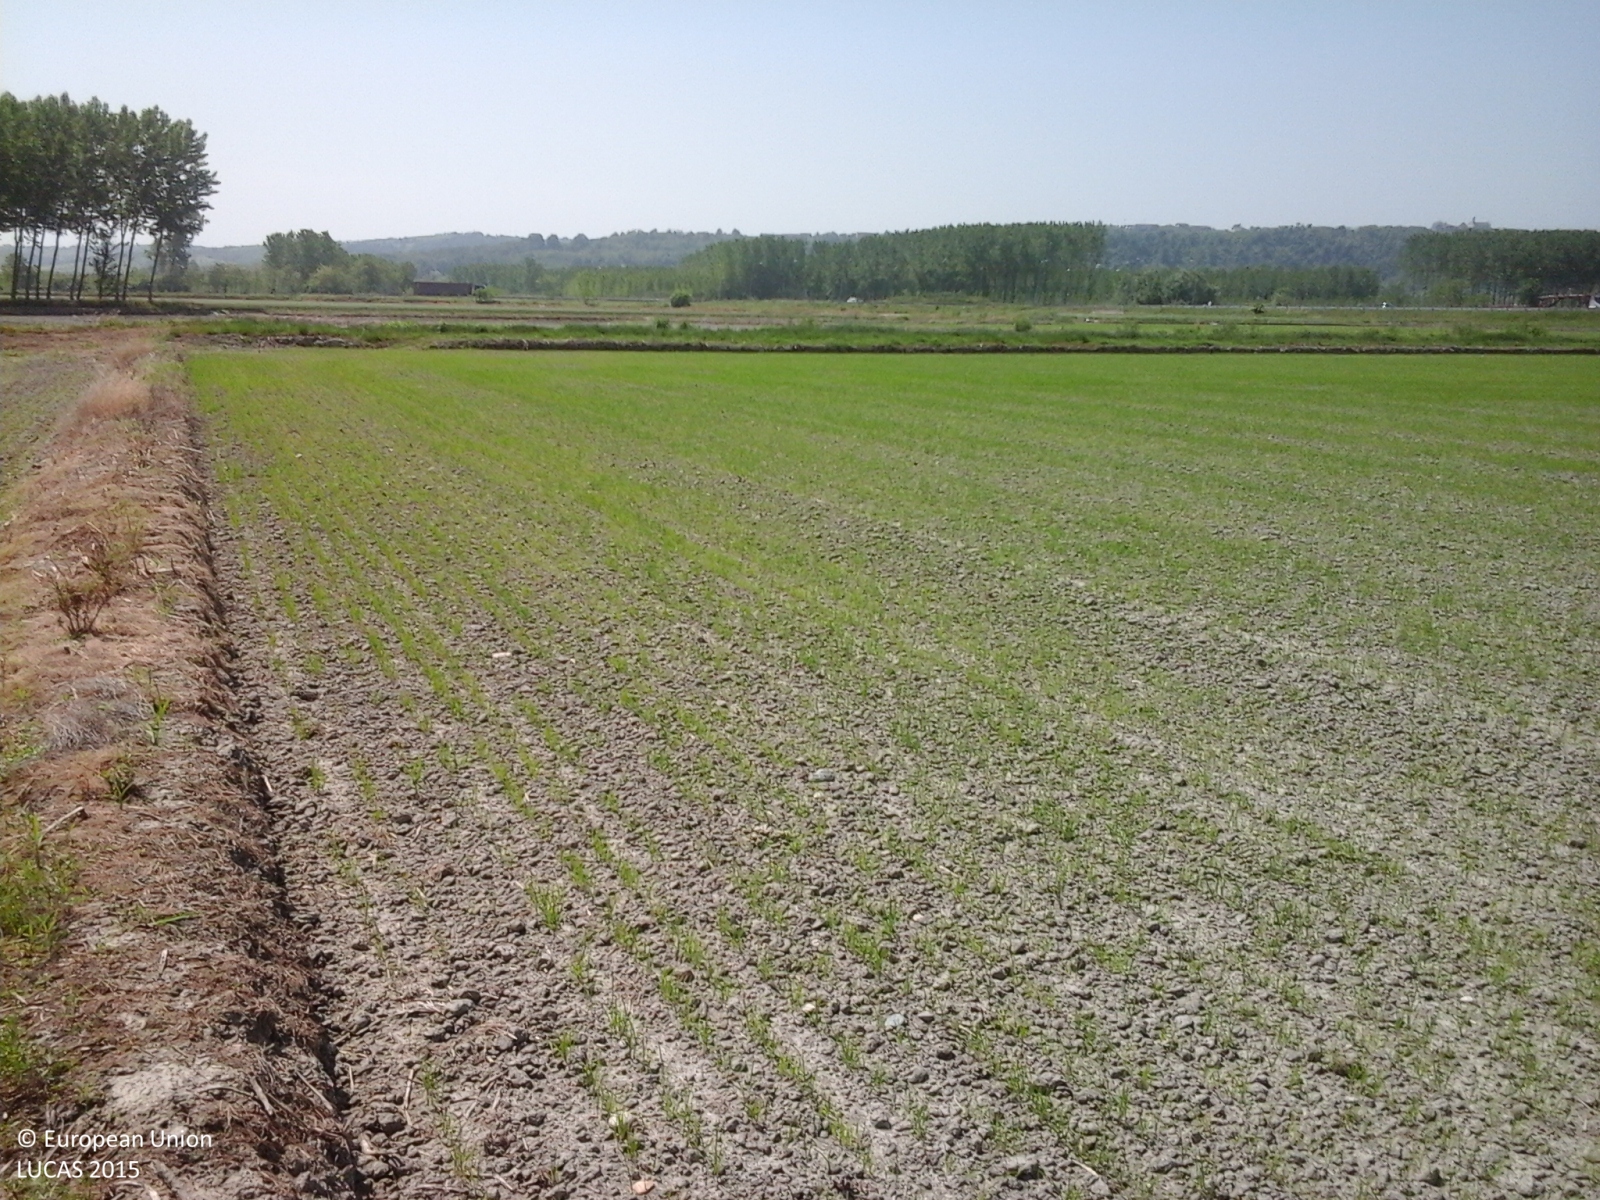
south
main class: Cropland
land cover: Rice
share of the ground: 10 - 25 %
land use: Agriculture (excluding fallow land and kitchen gardens)
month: May
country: IT
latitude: 45.1676
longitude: 8.3871
